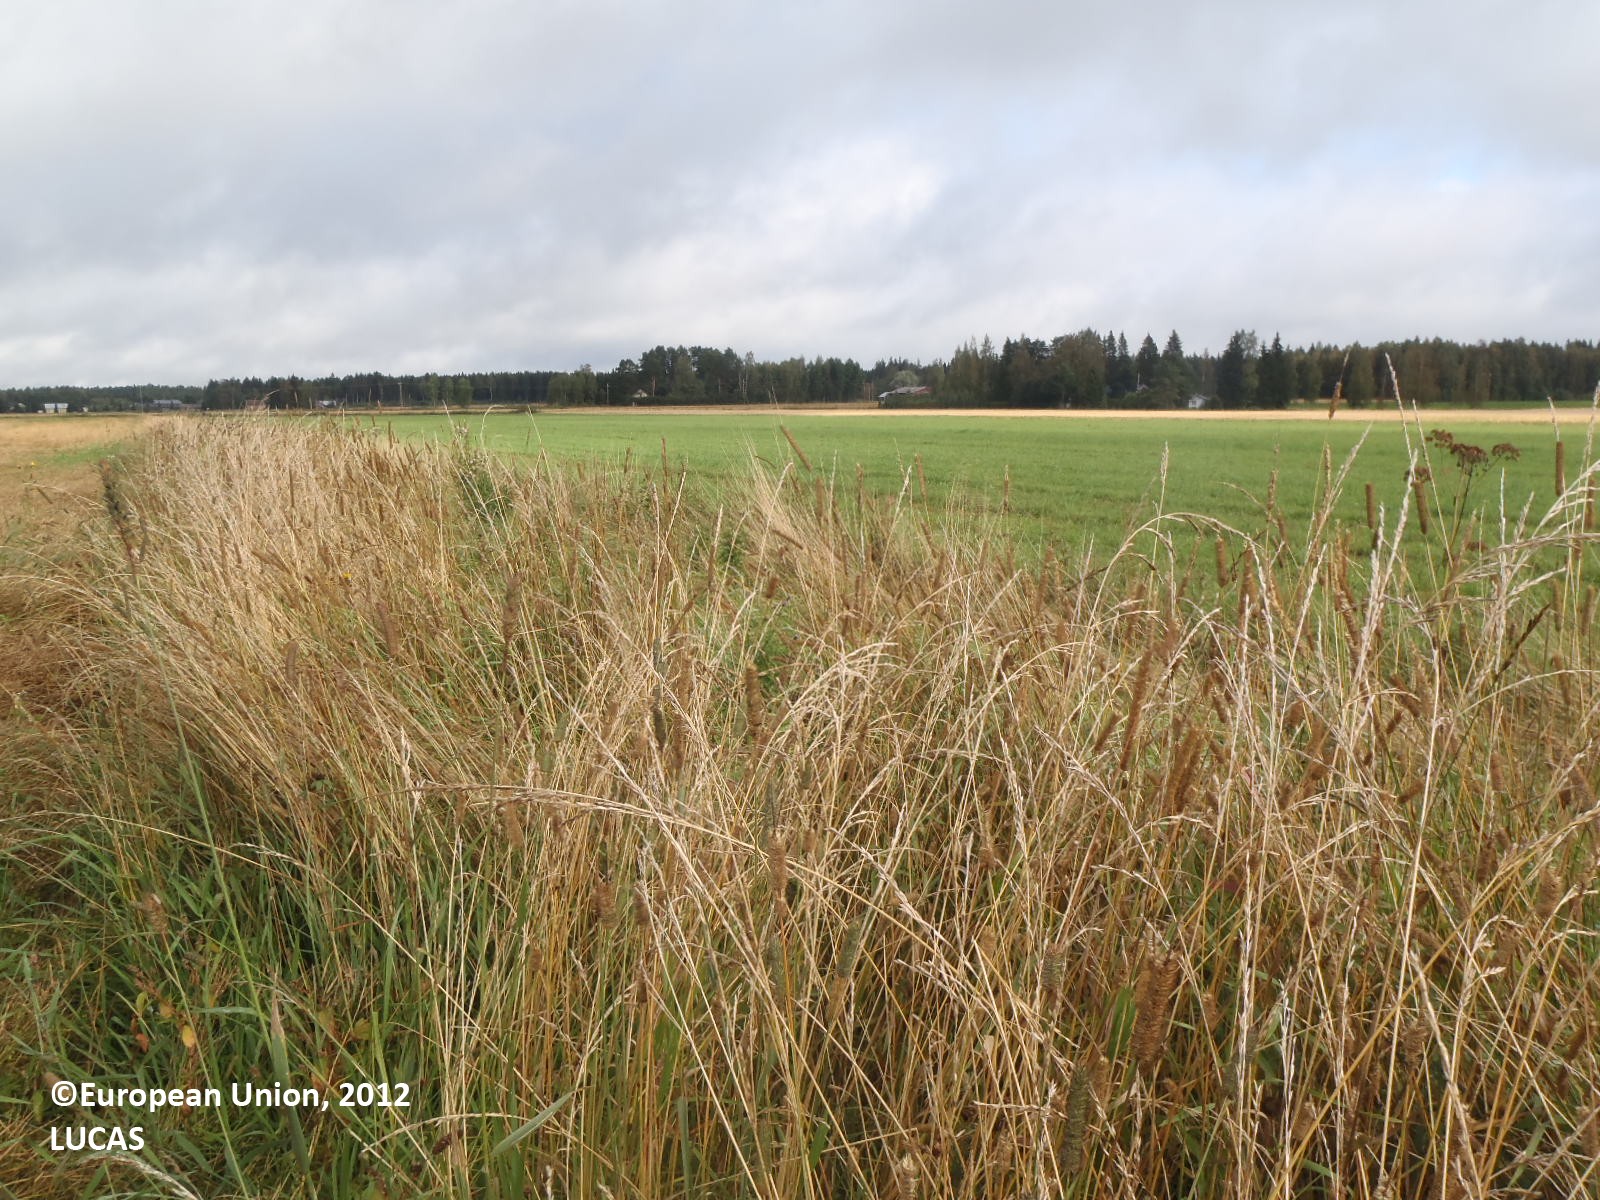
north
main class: Cropland
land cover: Rape and turnip rape
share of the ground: > 75 %
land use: Agriculture (excluding fallow land and kitchen gardens)
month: September
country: FI
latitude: 60.9672
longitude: 22.5737
